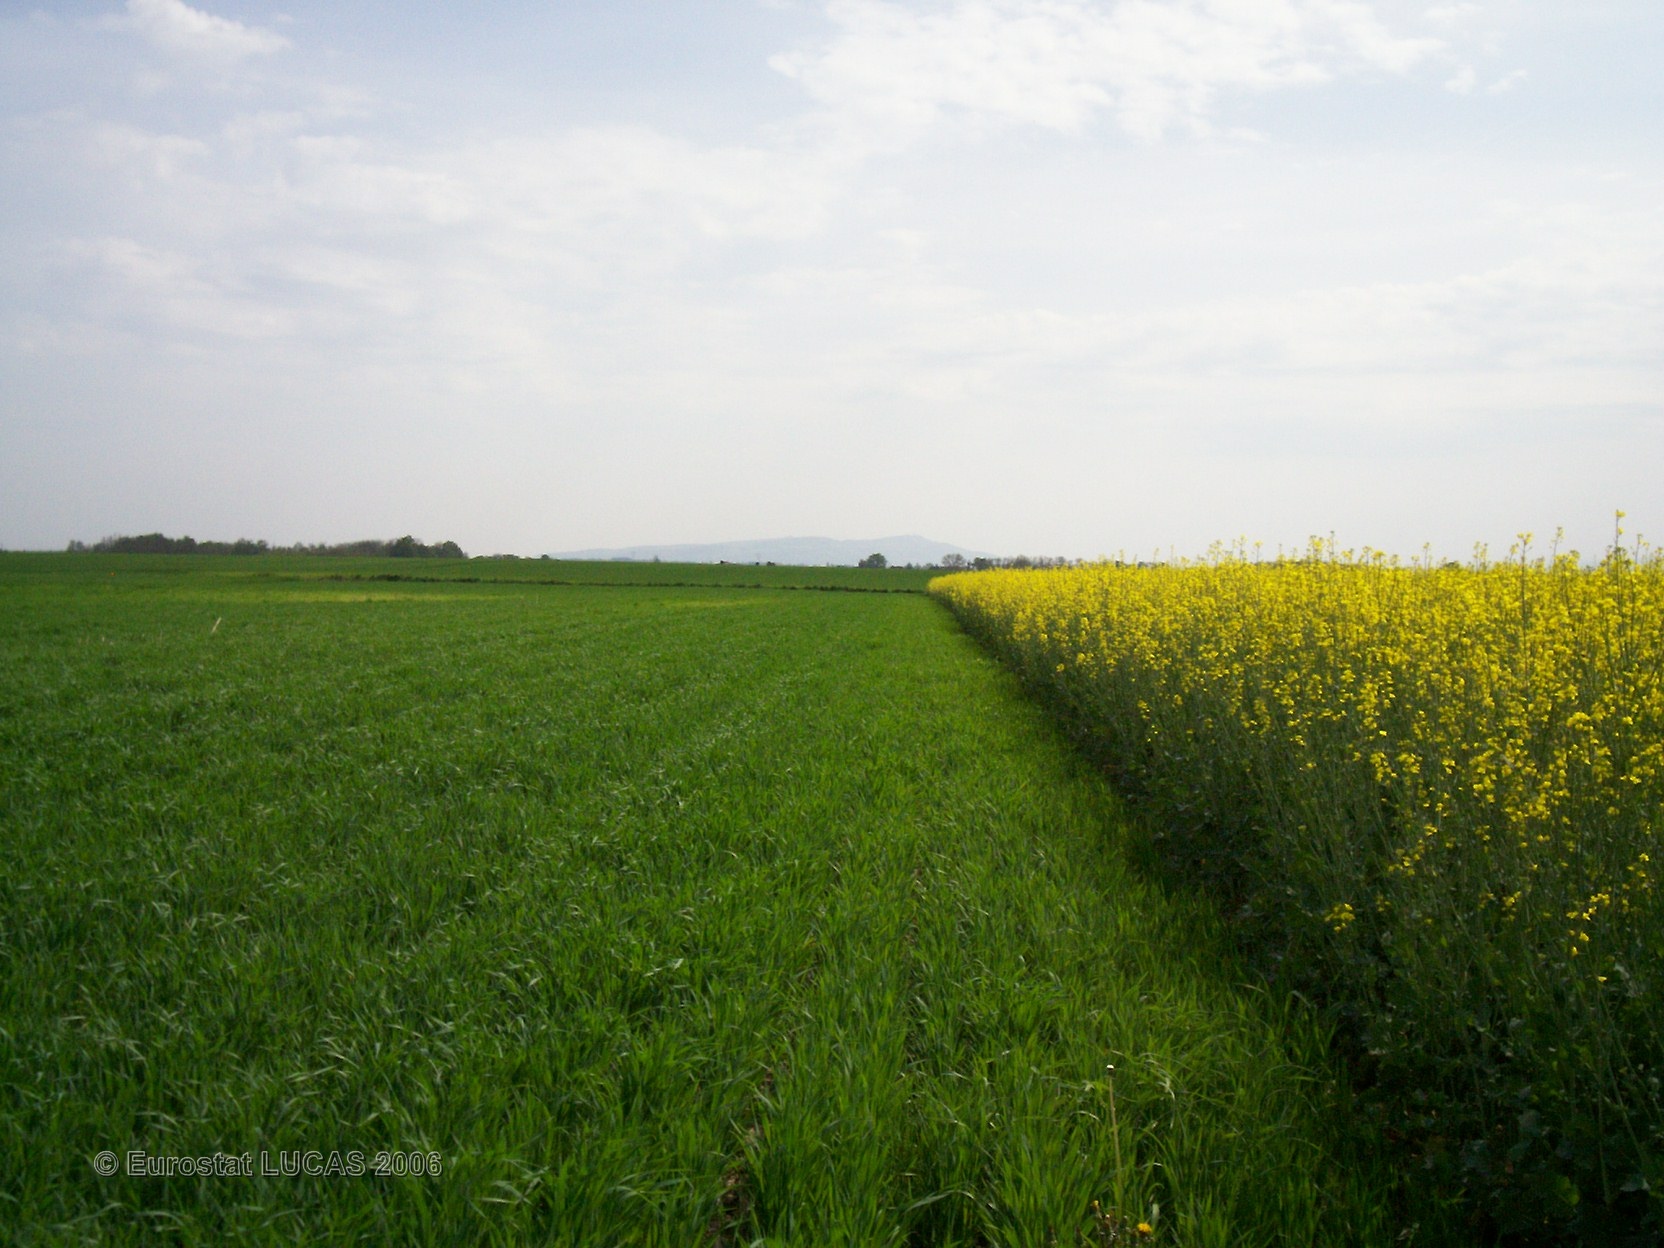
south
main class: Cropland
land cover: Oats
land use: Agriculture (excluding fallow land and kitchen gardens)
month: May
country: FR
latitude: 46.0068
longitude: 4.7727
